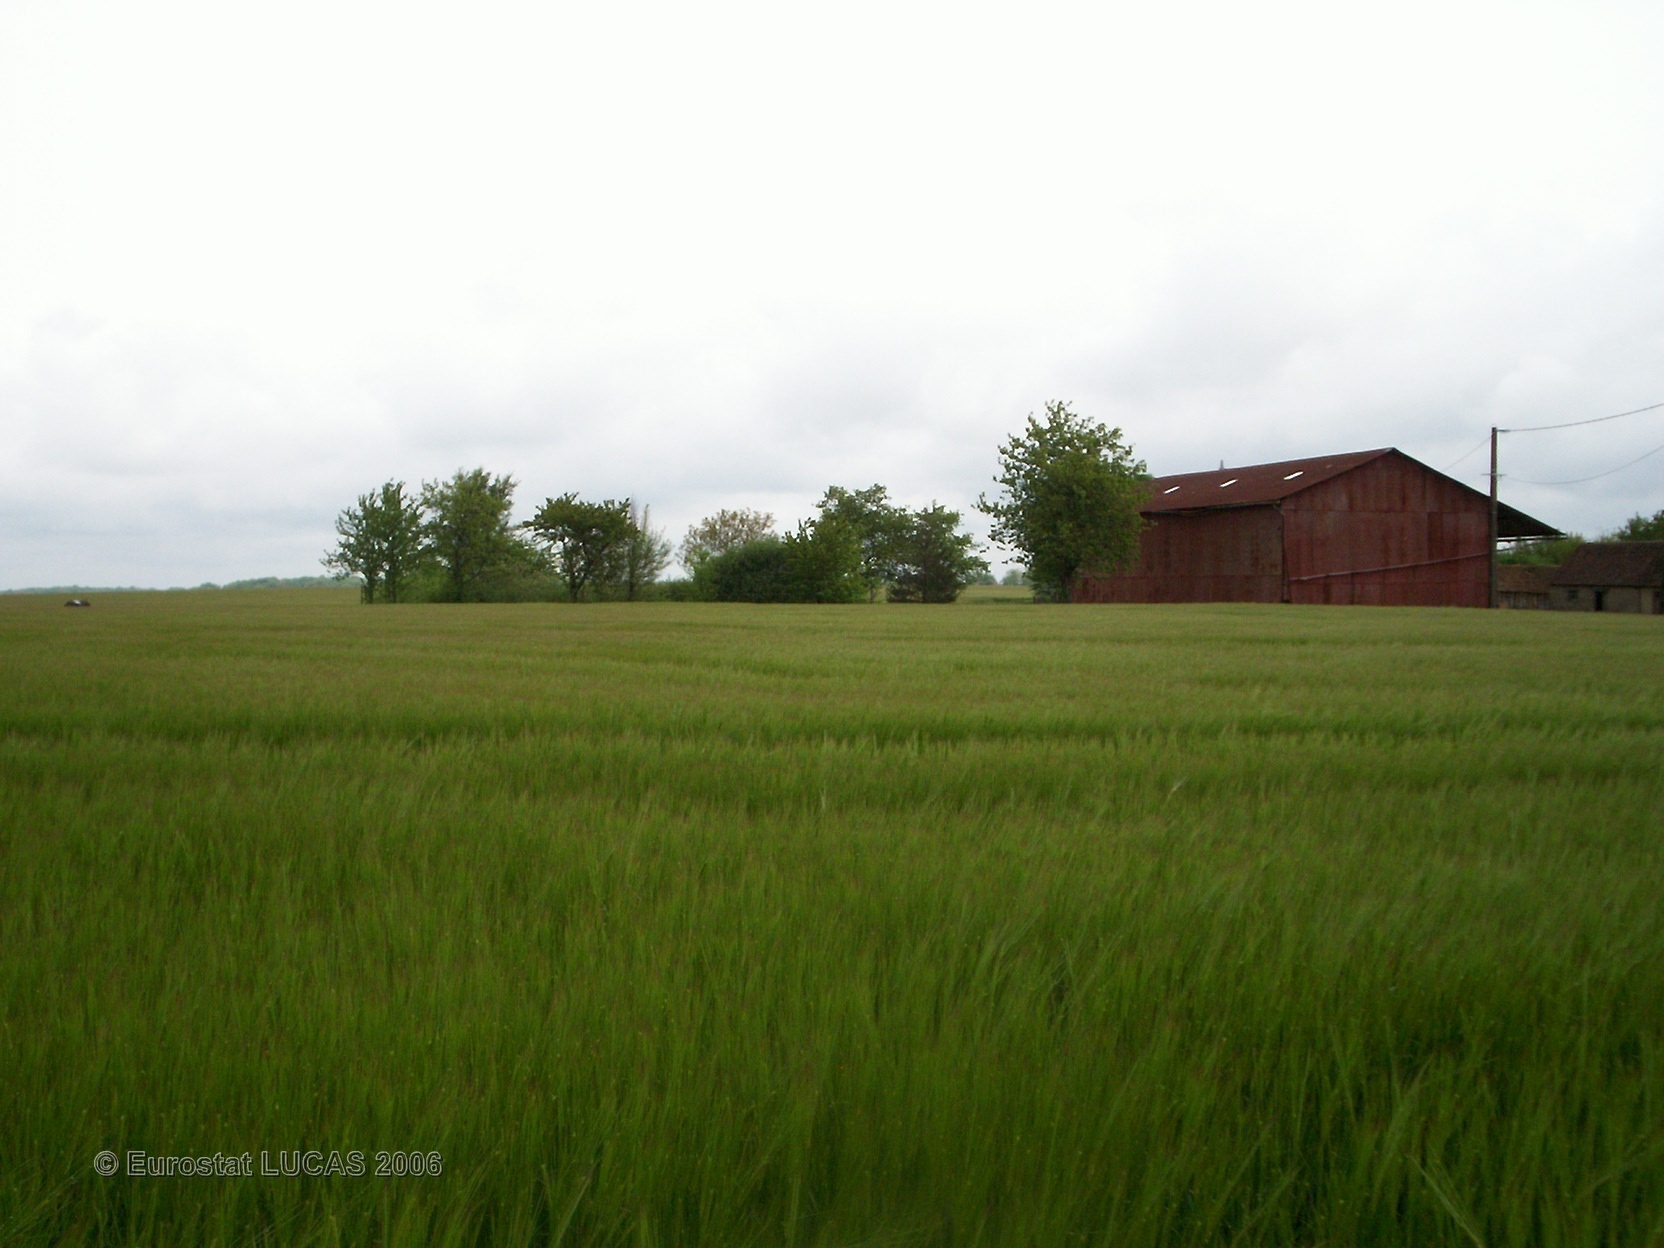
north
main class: Cropland
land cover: Barley
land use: Agriculture (excluding fallow land and kitchen gardens)
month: May
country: FR
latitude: 47.9982
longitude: 2.9566
